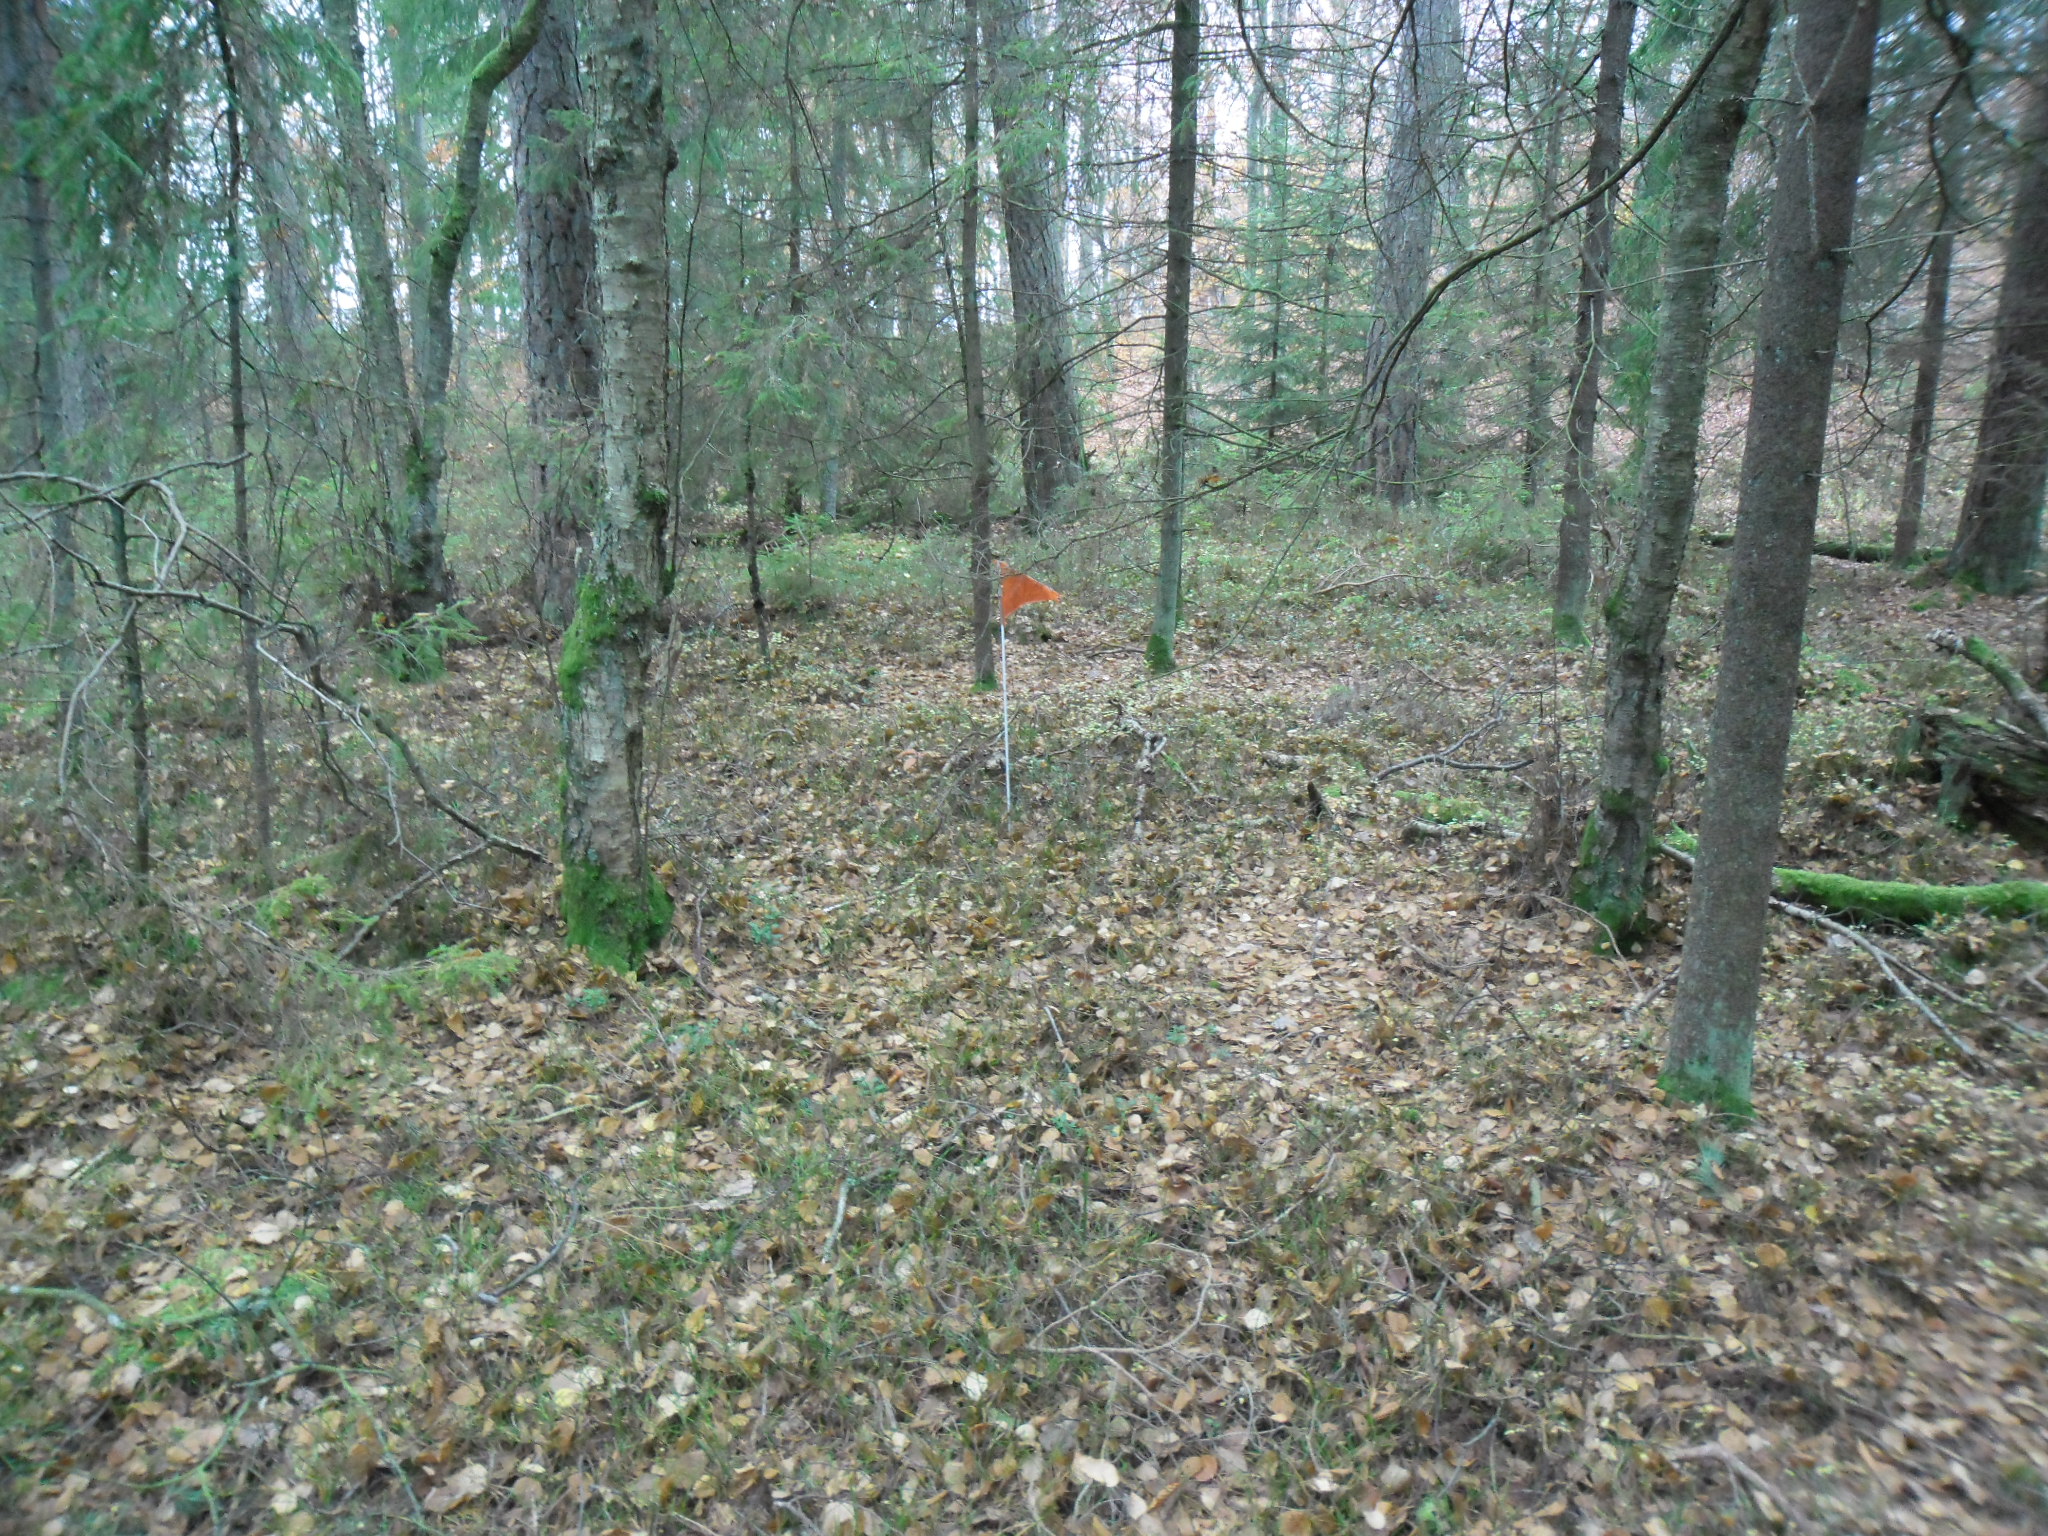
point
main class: Woodland
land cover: Pine dominated mixed woodland
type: boreal forest
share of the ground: > 75 %
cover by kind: coniferous forest trees 60 %, broadleaved forest trees 20 %, shrubs 20 %
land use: Forestry
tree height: > 5 m
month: November
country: SE
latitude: 56.3126
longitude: 13.0849
